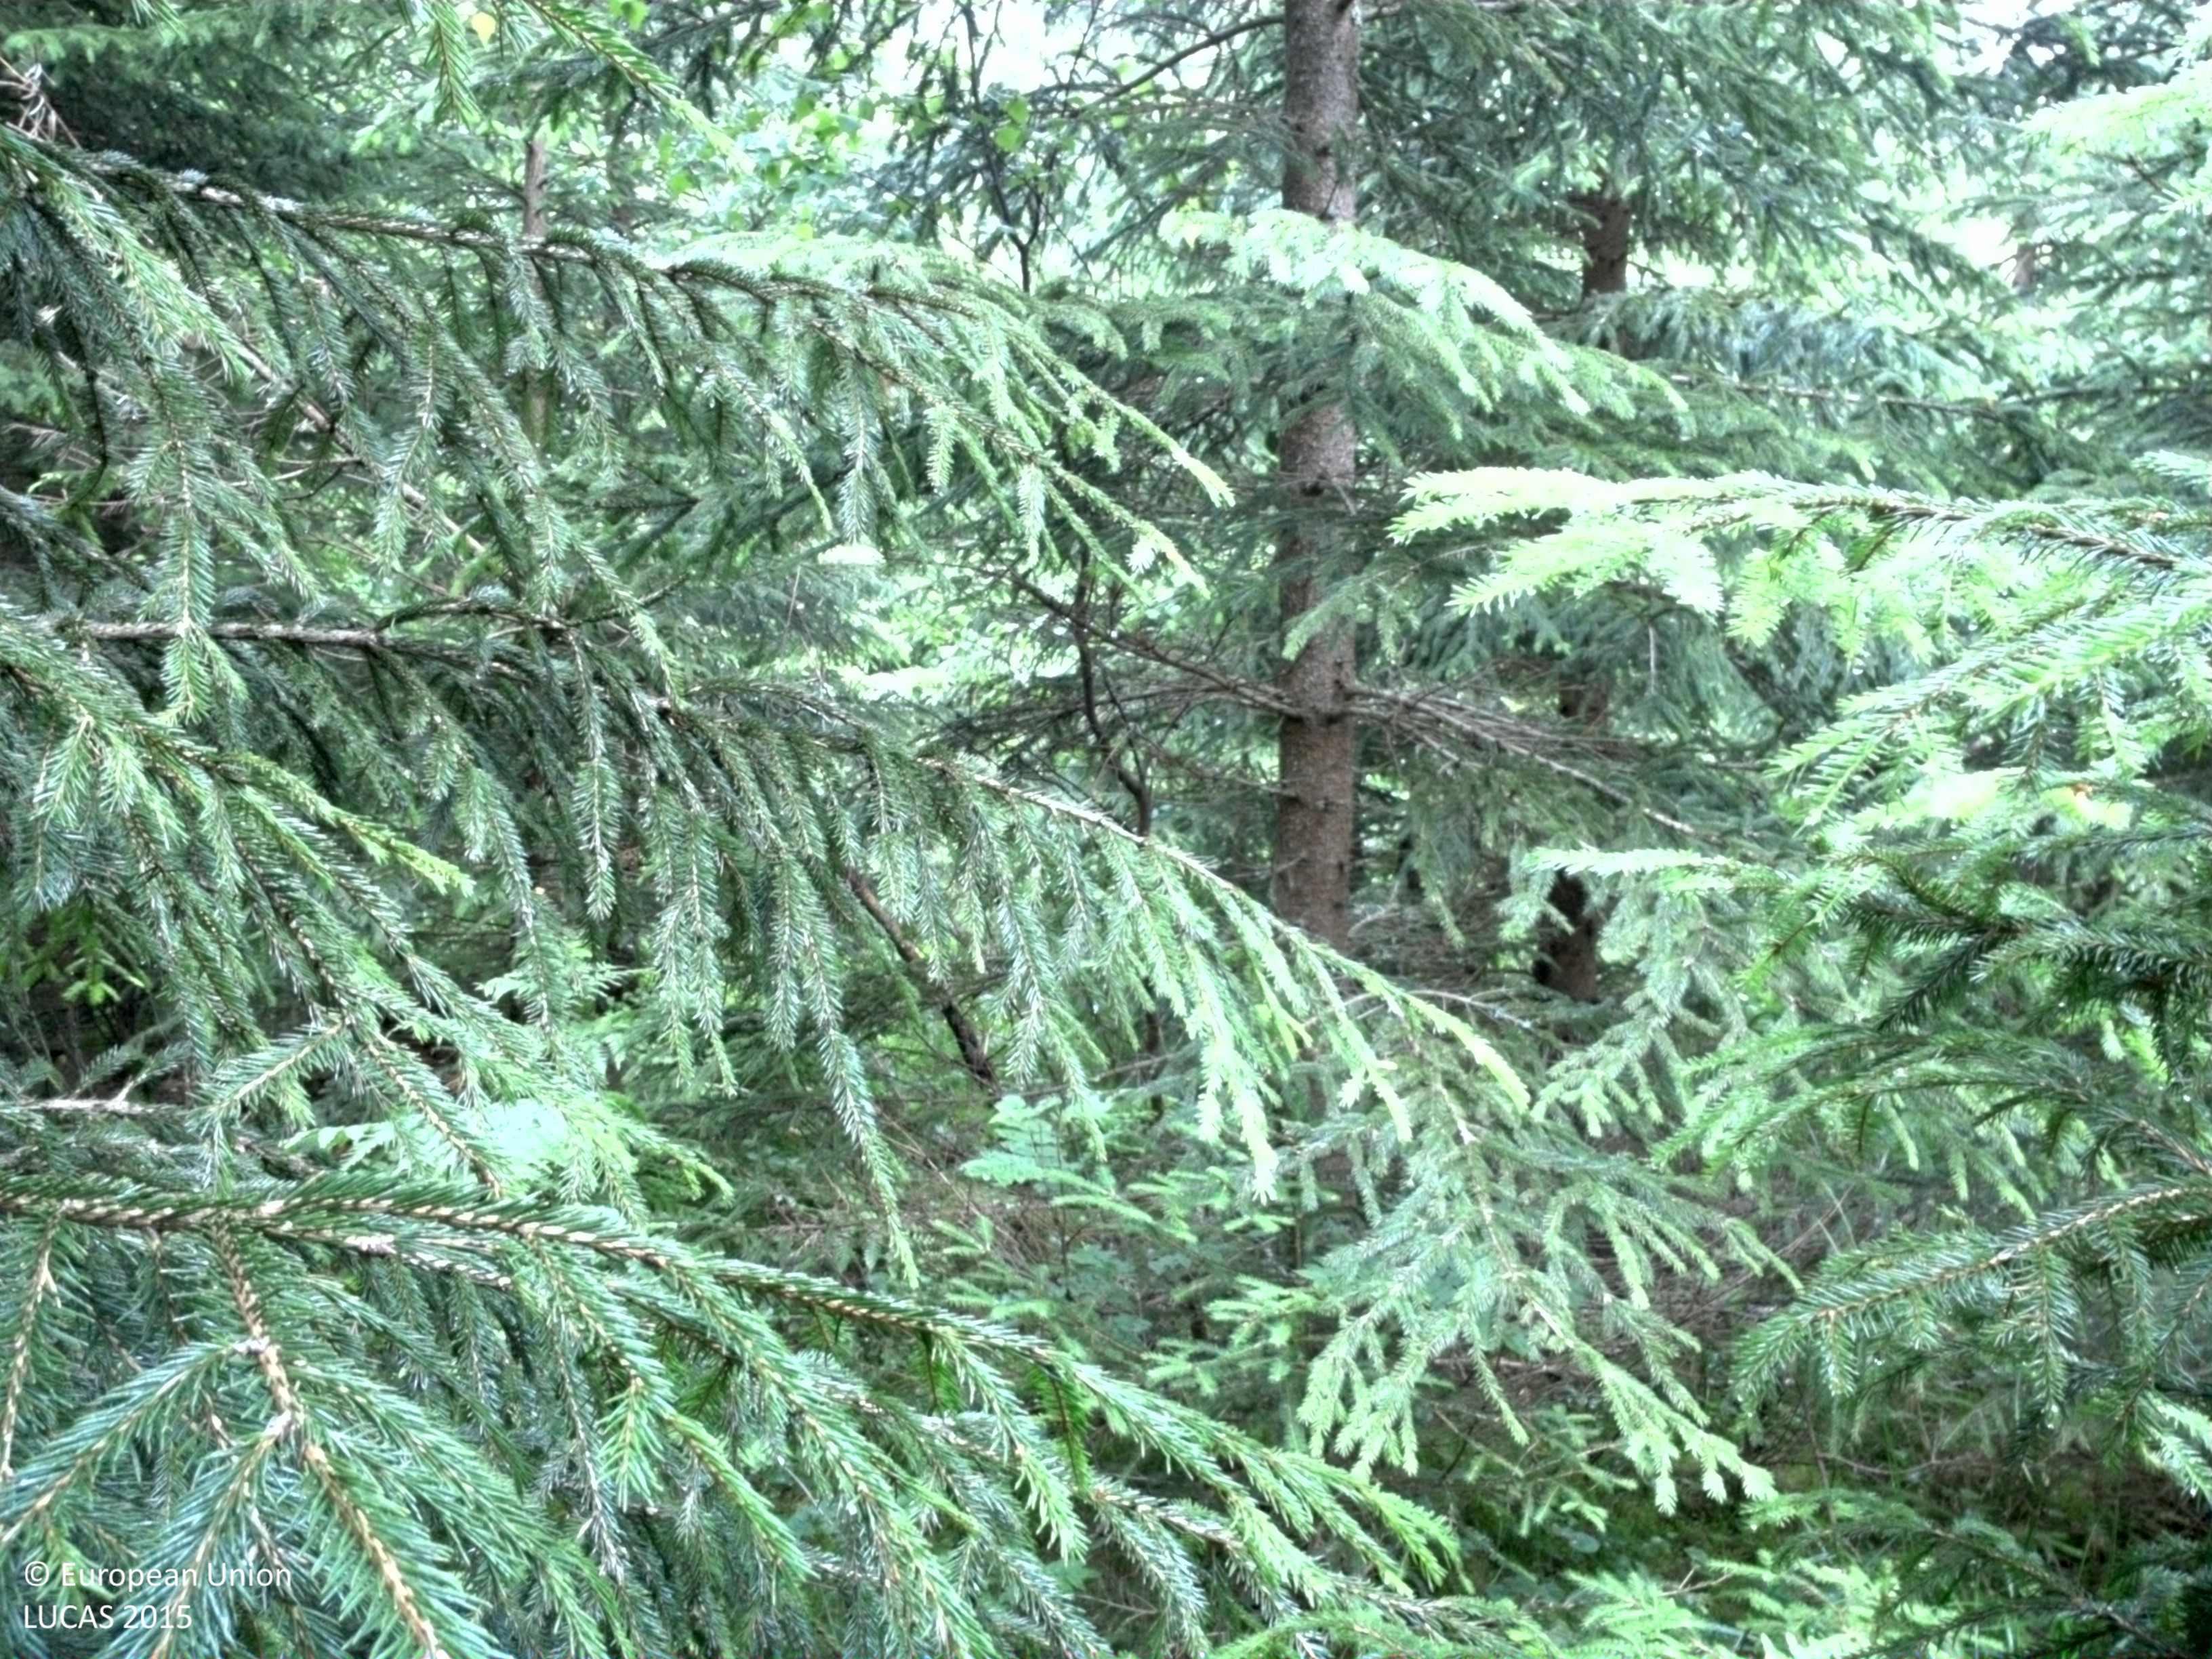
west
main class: Woodland
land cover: Spruce dominated coniferous woodland
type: boreal forest
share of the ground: > 75 %
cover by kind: coniferous forest trees 90 %, herbaceous plants 10 %
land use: Forestry
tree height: < 5 m
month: July
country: SE
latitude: 59.9934
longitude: 18.5489
